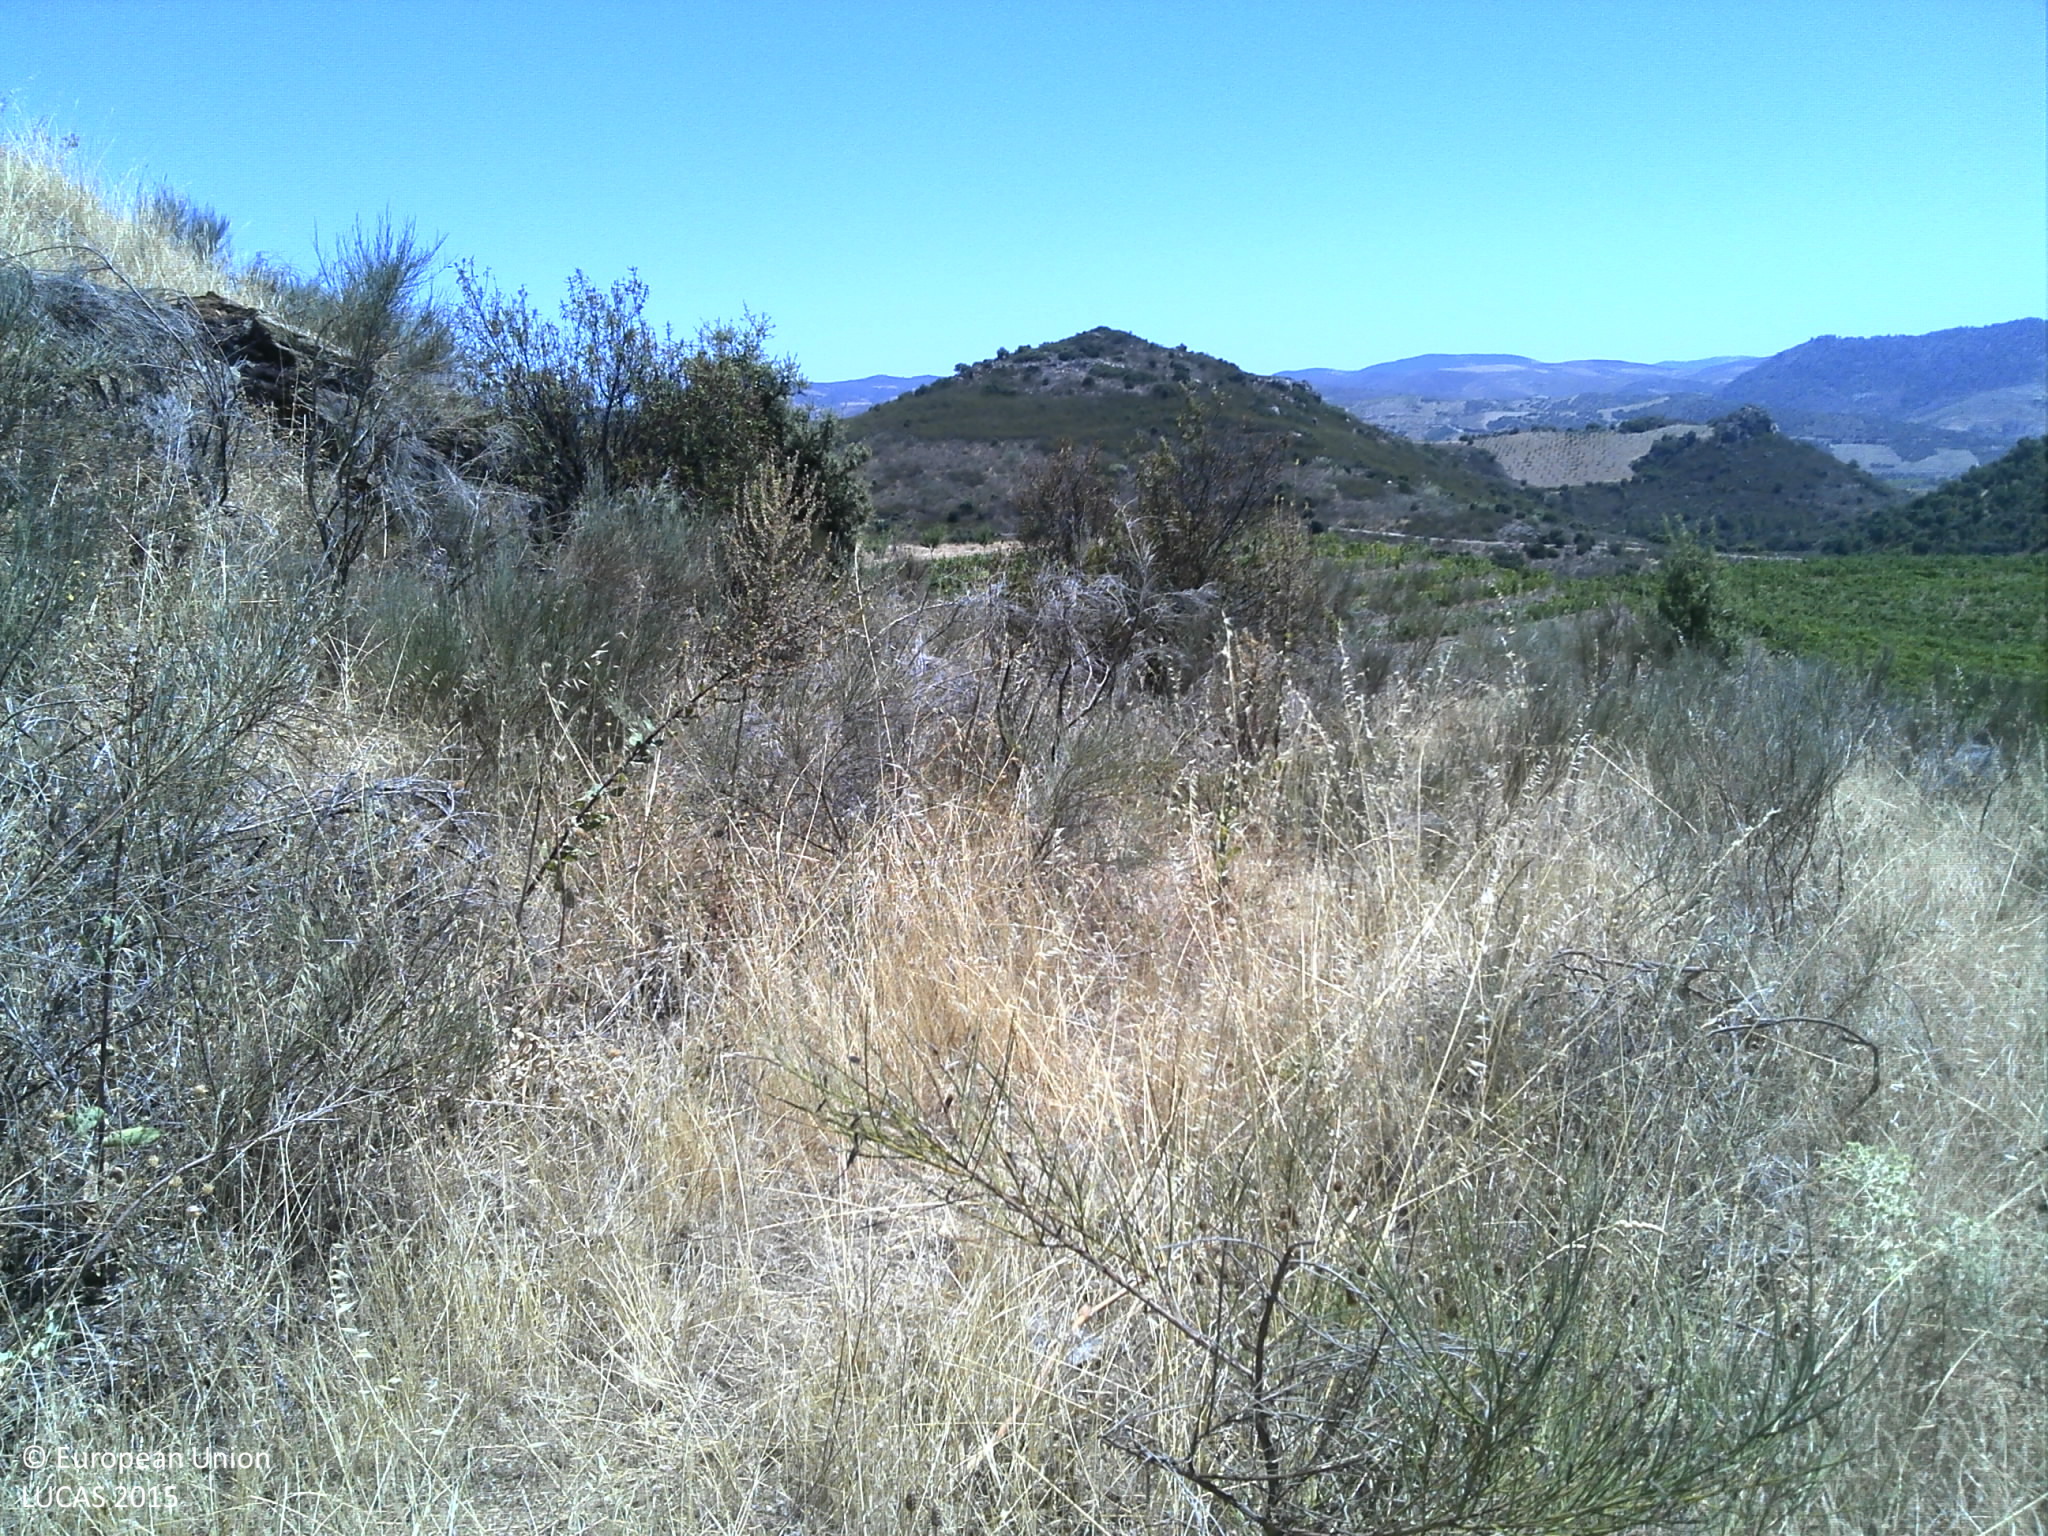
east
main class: Shrubland
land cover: Shrubland without tree cover
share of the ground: > 75 %
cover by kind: shrubs 80 %, herbaceous plants 20 %
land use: Abandoned areas
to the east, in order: Shrubland without tree cover; Single bushes/trees; Shrubland without tree cover; Paved roads, cycling and walking lanes; Grass margins; Tracks; Nuts trees
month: July
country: PT
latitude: 41.3138
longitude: -7.1127
